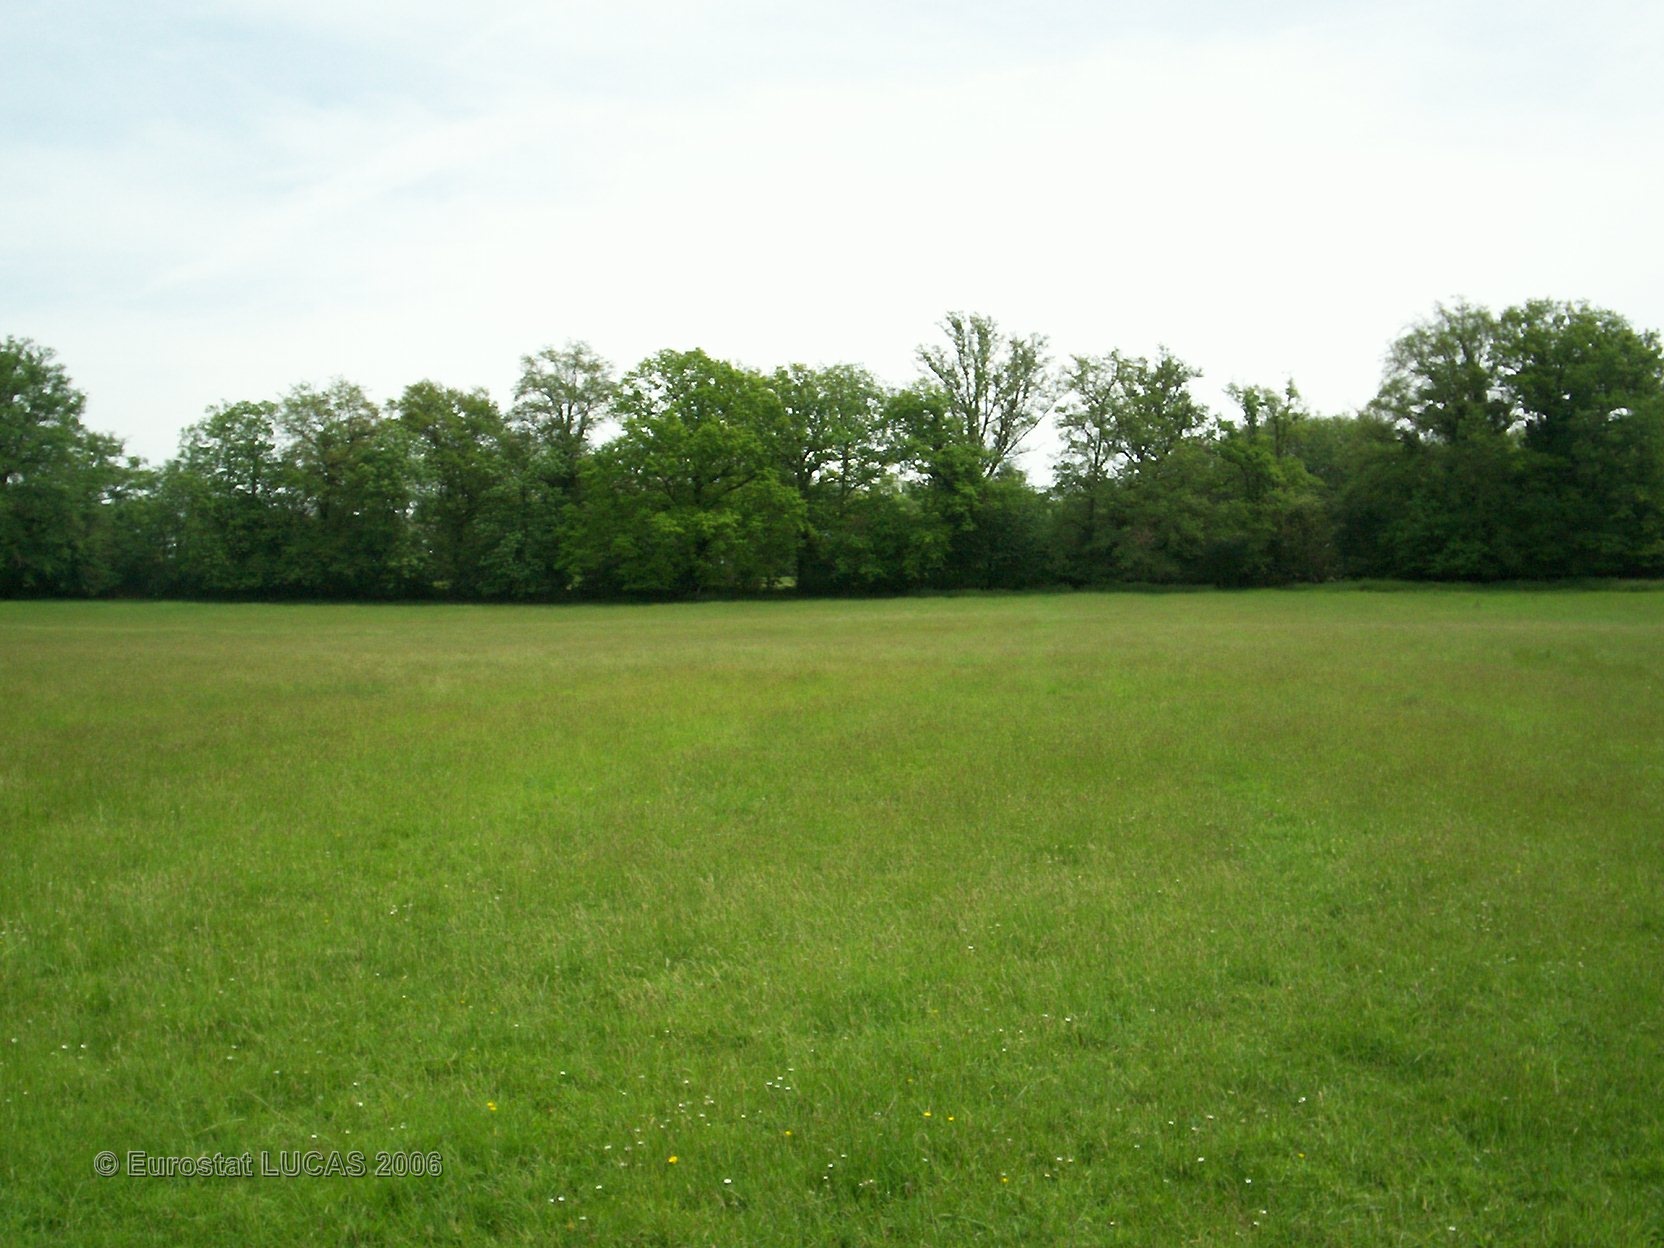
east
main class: Grassland
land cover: Grassland without tree/shrub cover
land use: Agriculture (excluding fallow land and kitchen gardens)
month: May
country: FR
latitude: 46.1622
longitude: 1.1176
